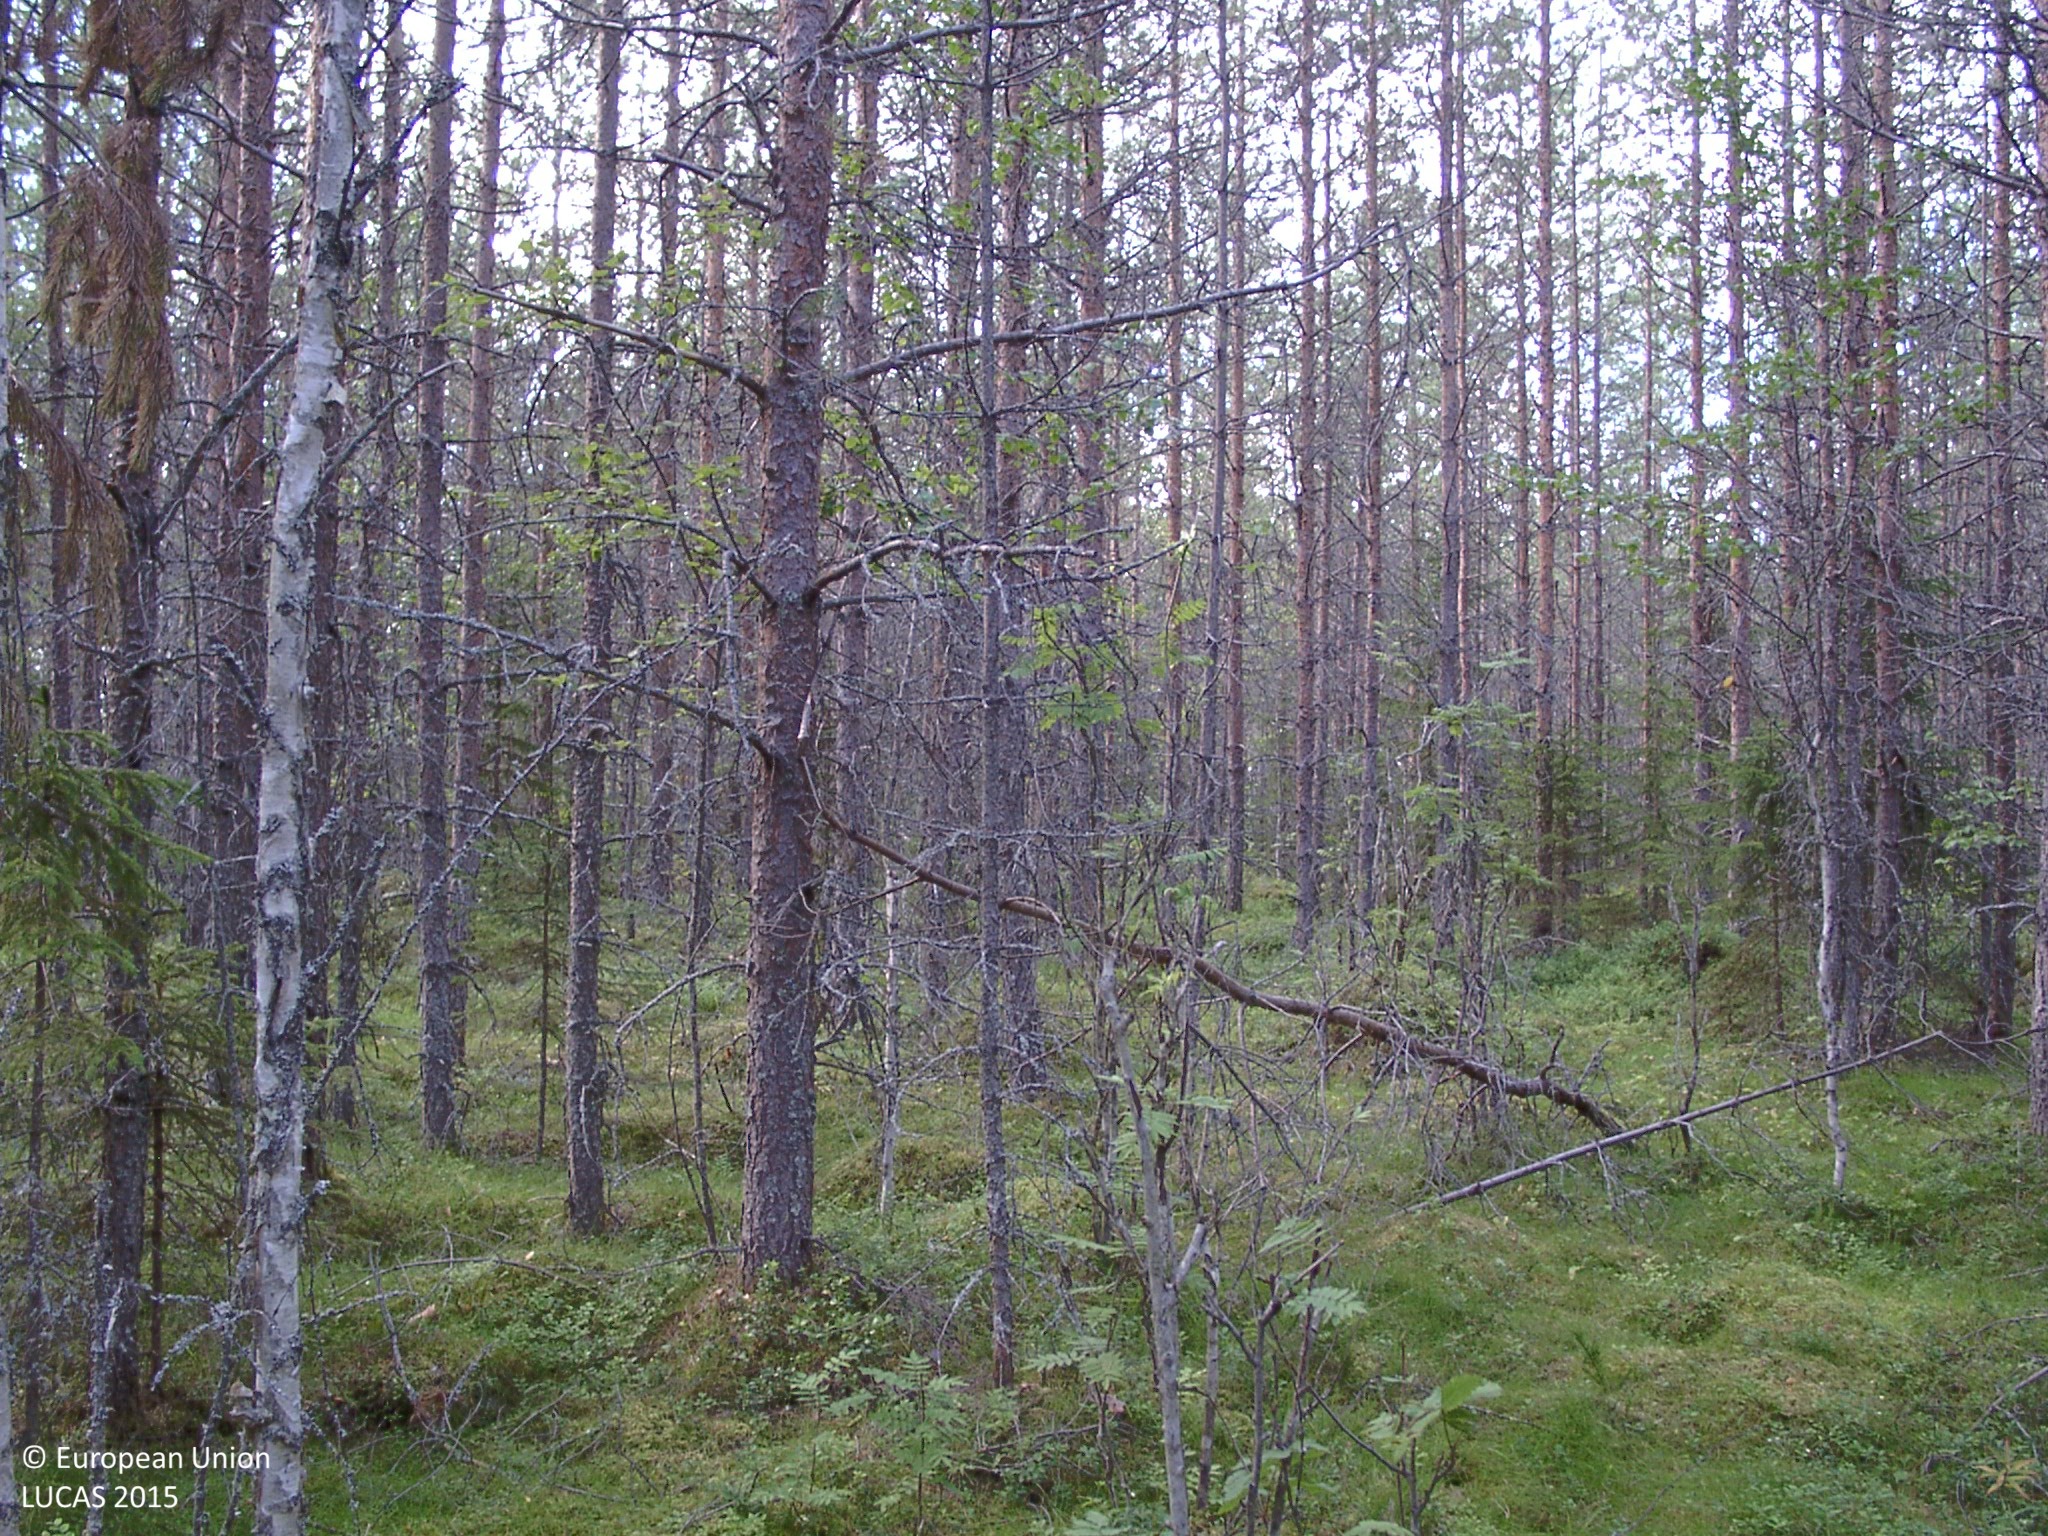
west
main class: Woodland
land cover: Pine dominated coniferous woodland
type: boreal forest
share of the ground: > 75 %
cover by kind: coniferous forest trees 75 %, shrubs 10 %, lichens and mosses 10 %, herbaceous plants 5 %
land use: Forestry
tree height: > 5 m
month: August
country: FI
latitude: 62.9718
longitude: 25.0681
